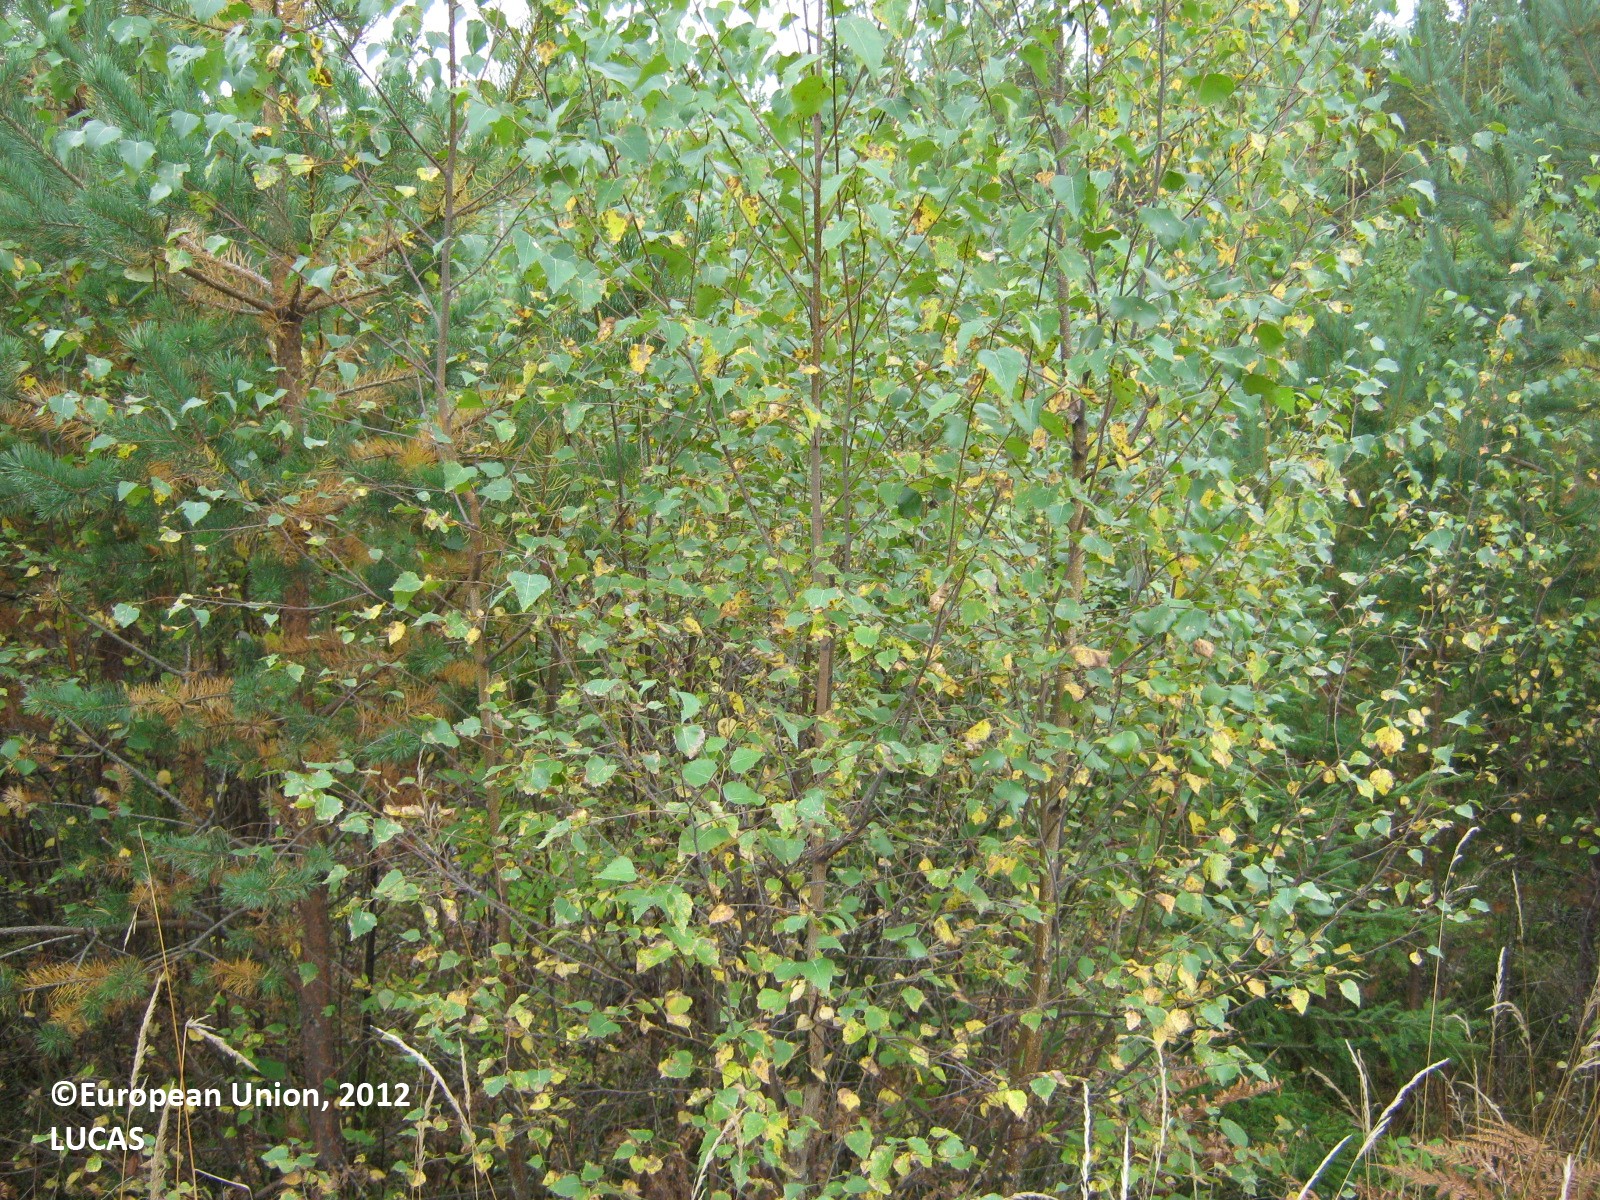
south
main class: Woodland
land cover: Pine dominated mixed woodland
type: boreal forest
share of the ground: > 75 %
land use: Forestry
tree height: < 5 m
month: September
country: FI
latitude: 60.8261
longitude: 28.1359
